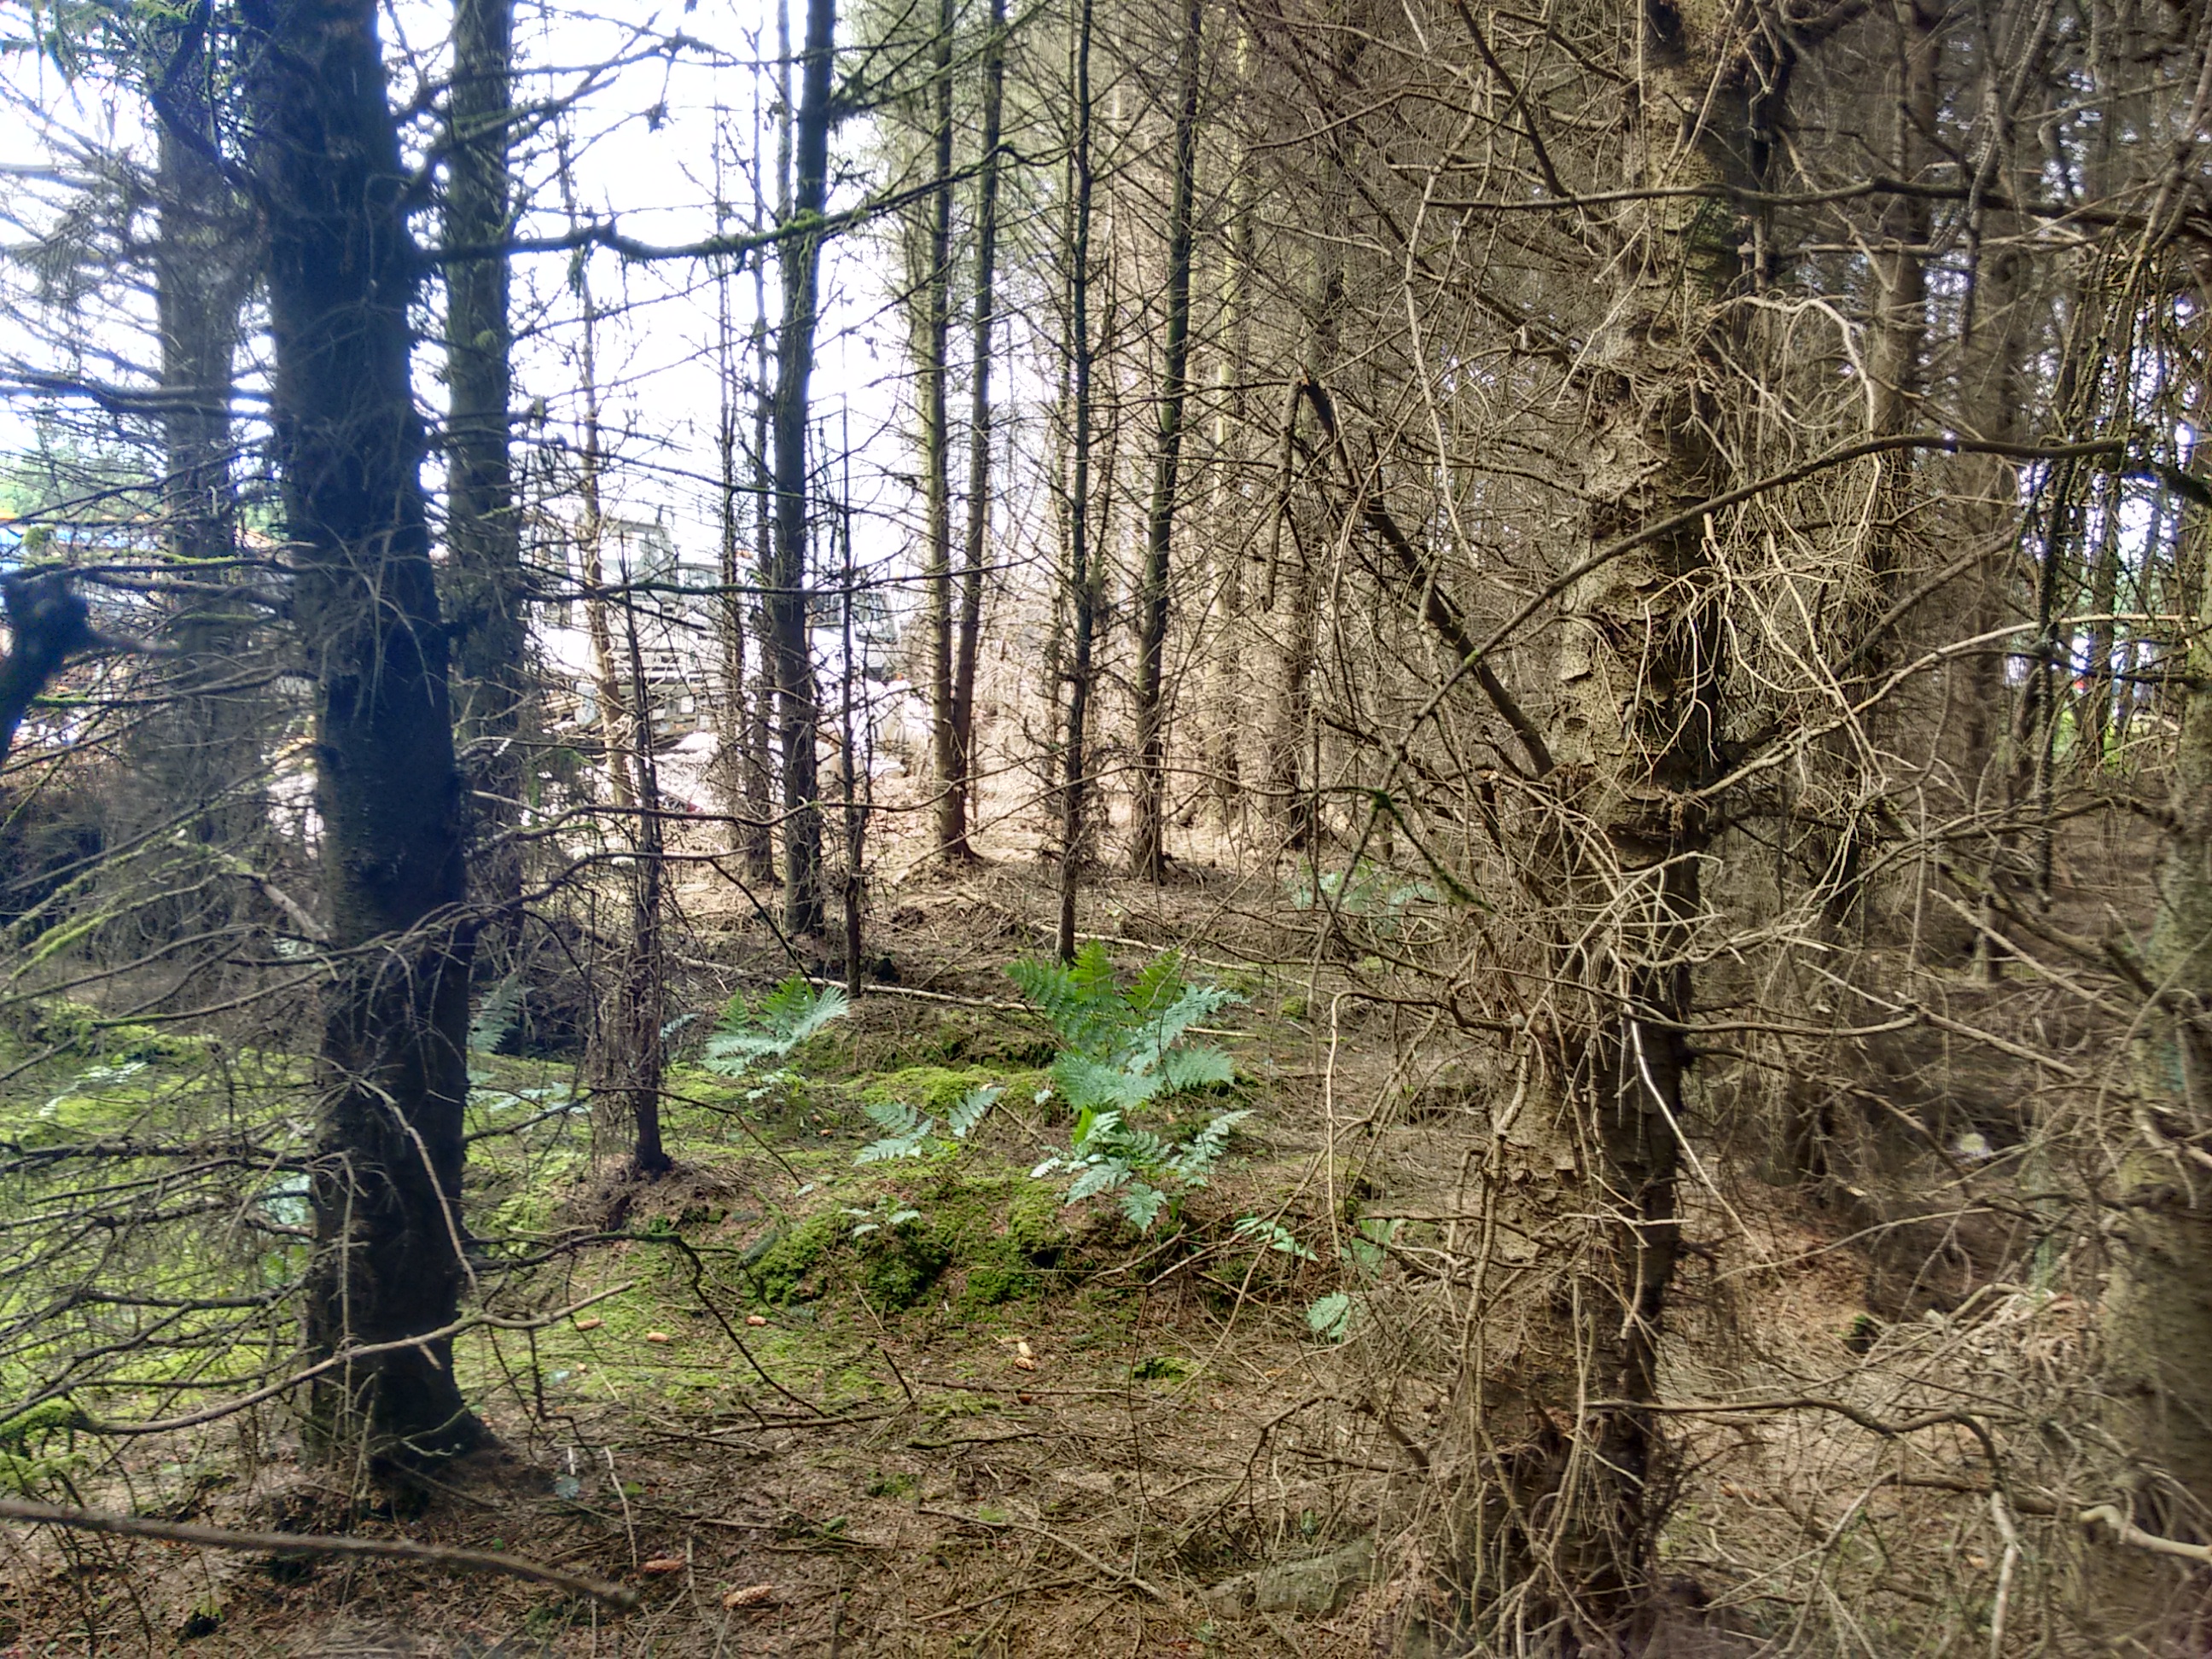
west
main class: Woodland
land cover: Spruce dominated coniferous woodland
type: exotic forest
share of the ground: > 75 %
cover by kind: coniferous forest trees 100 %
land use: Forestry
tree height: > 5 m
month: July
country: GB
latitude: 54.5905
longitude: -7.0559
